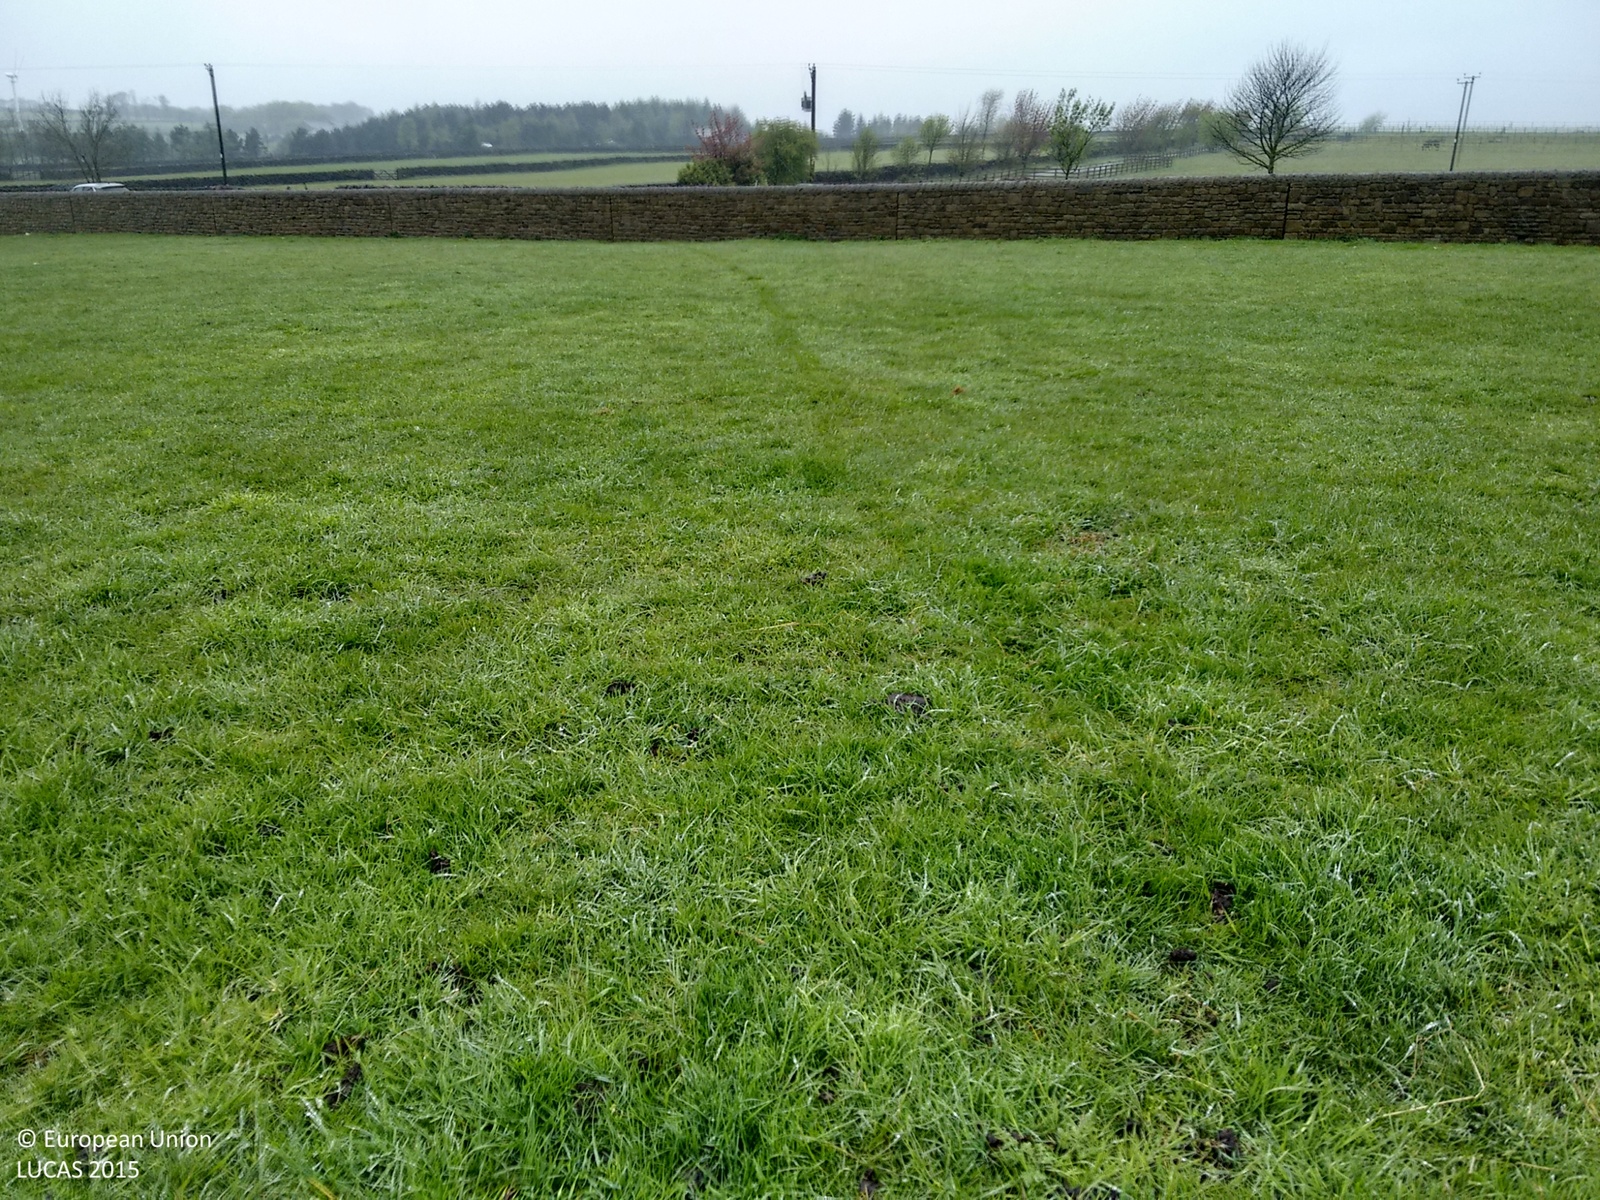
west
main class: Grassland
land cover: Grassland without tree/shrub cover
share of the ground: > 75 %
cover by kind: herbaceous plants 100 %
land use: Agriculture (excluding fallow land and kitchen gardens)
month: May
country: GB
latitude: 53.8288
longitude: -1.9218
